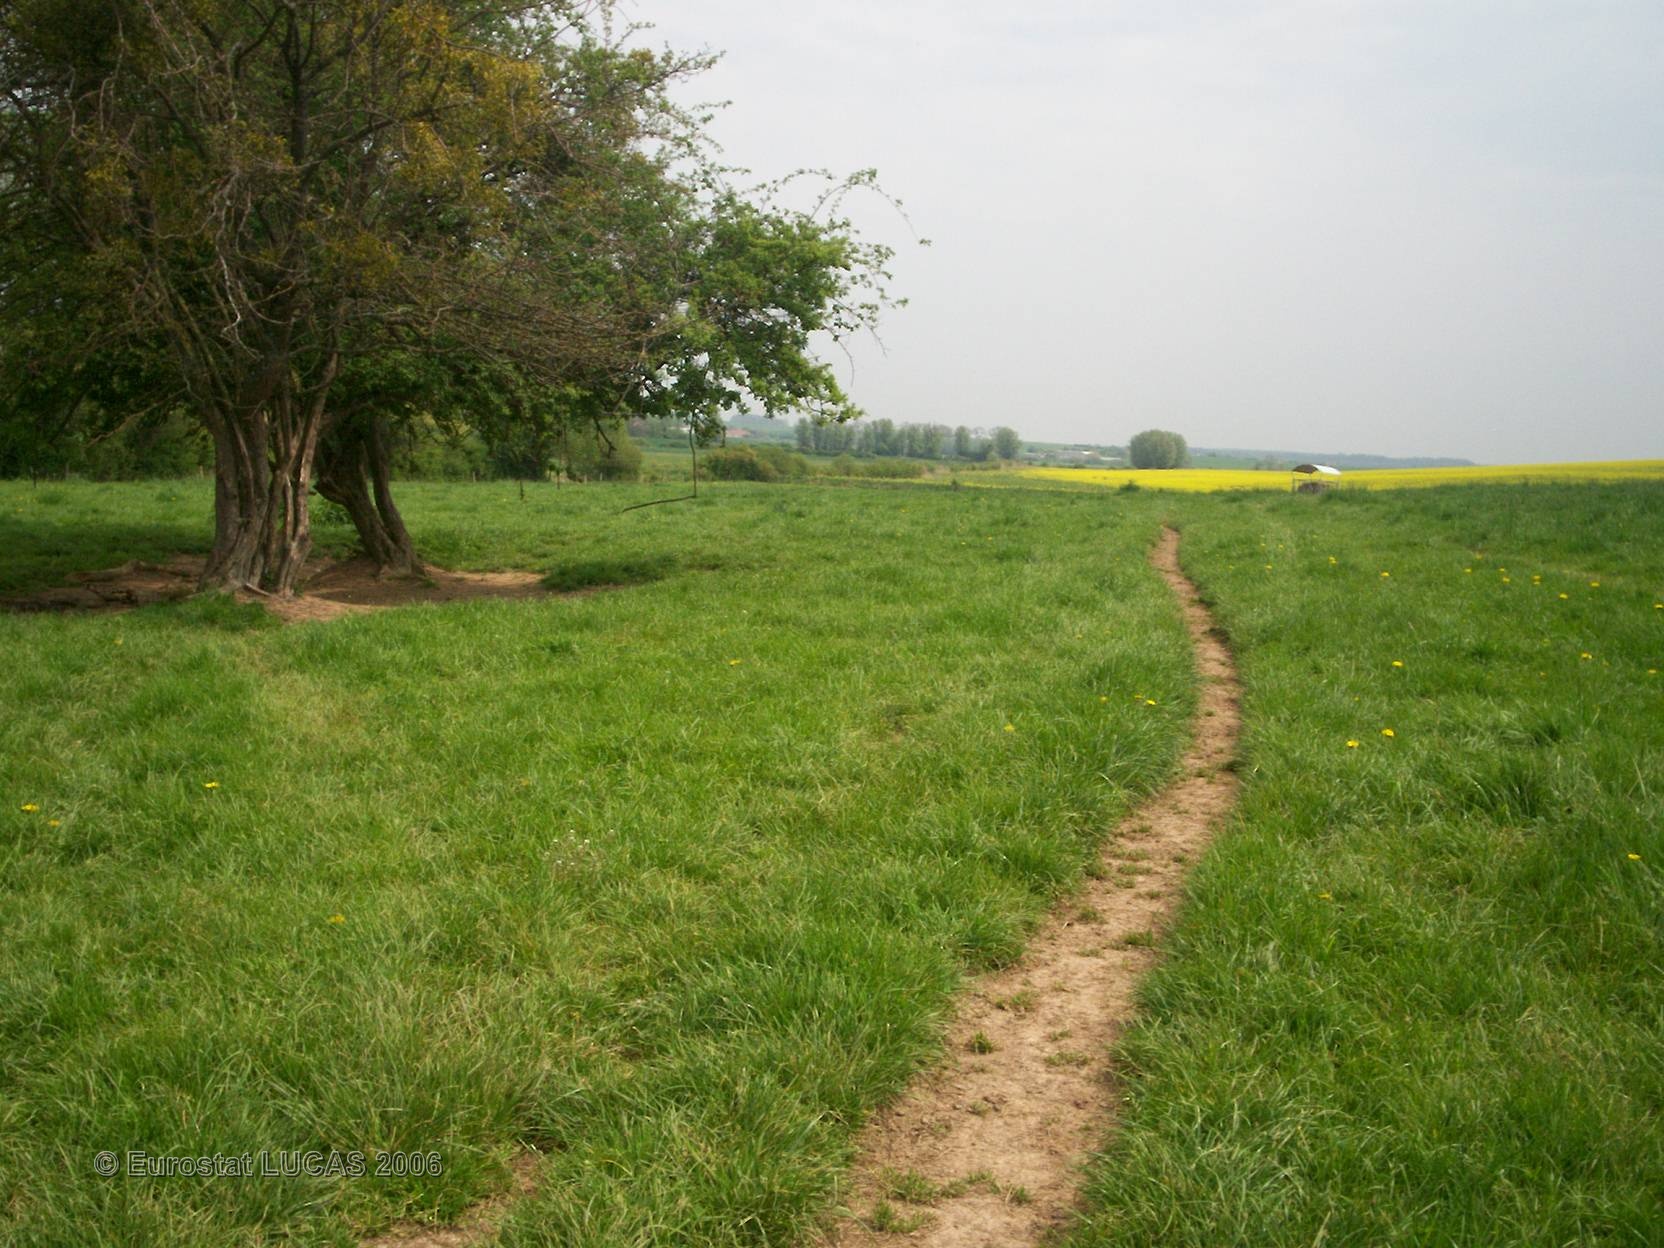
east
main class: Grassland
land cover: Grassland with sparse tree/shrub cover
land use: Agriculture (excluding fallow land and kitchen gardens)
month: May
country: FR
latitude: 48.8613
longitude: 6.7971
